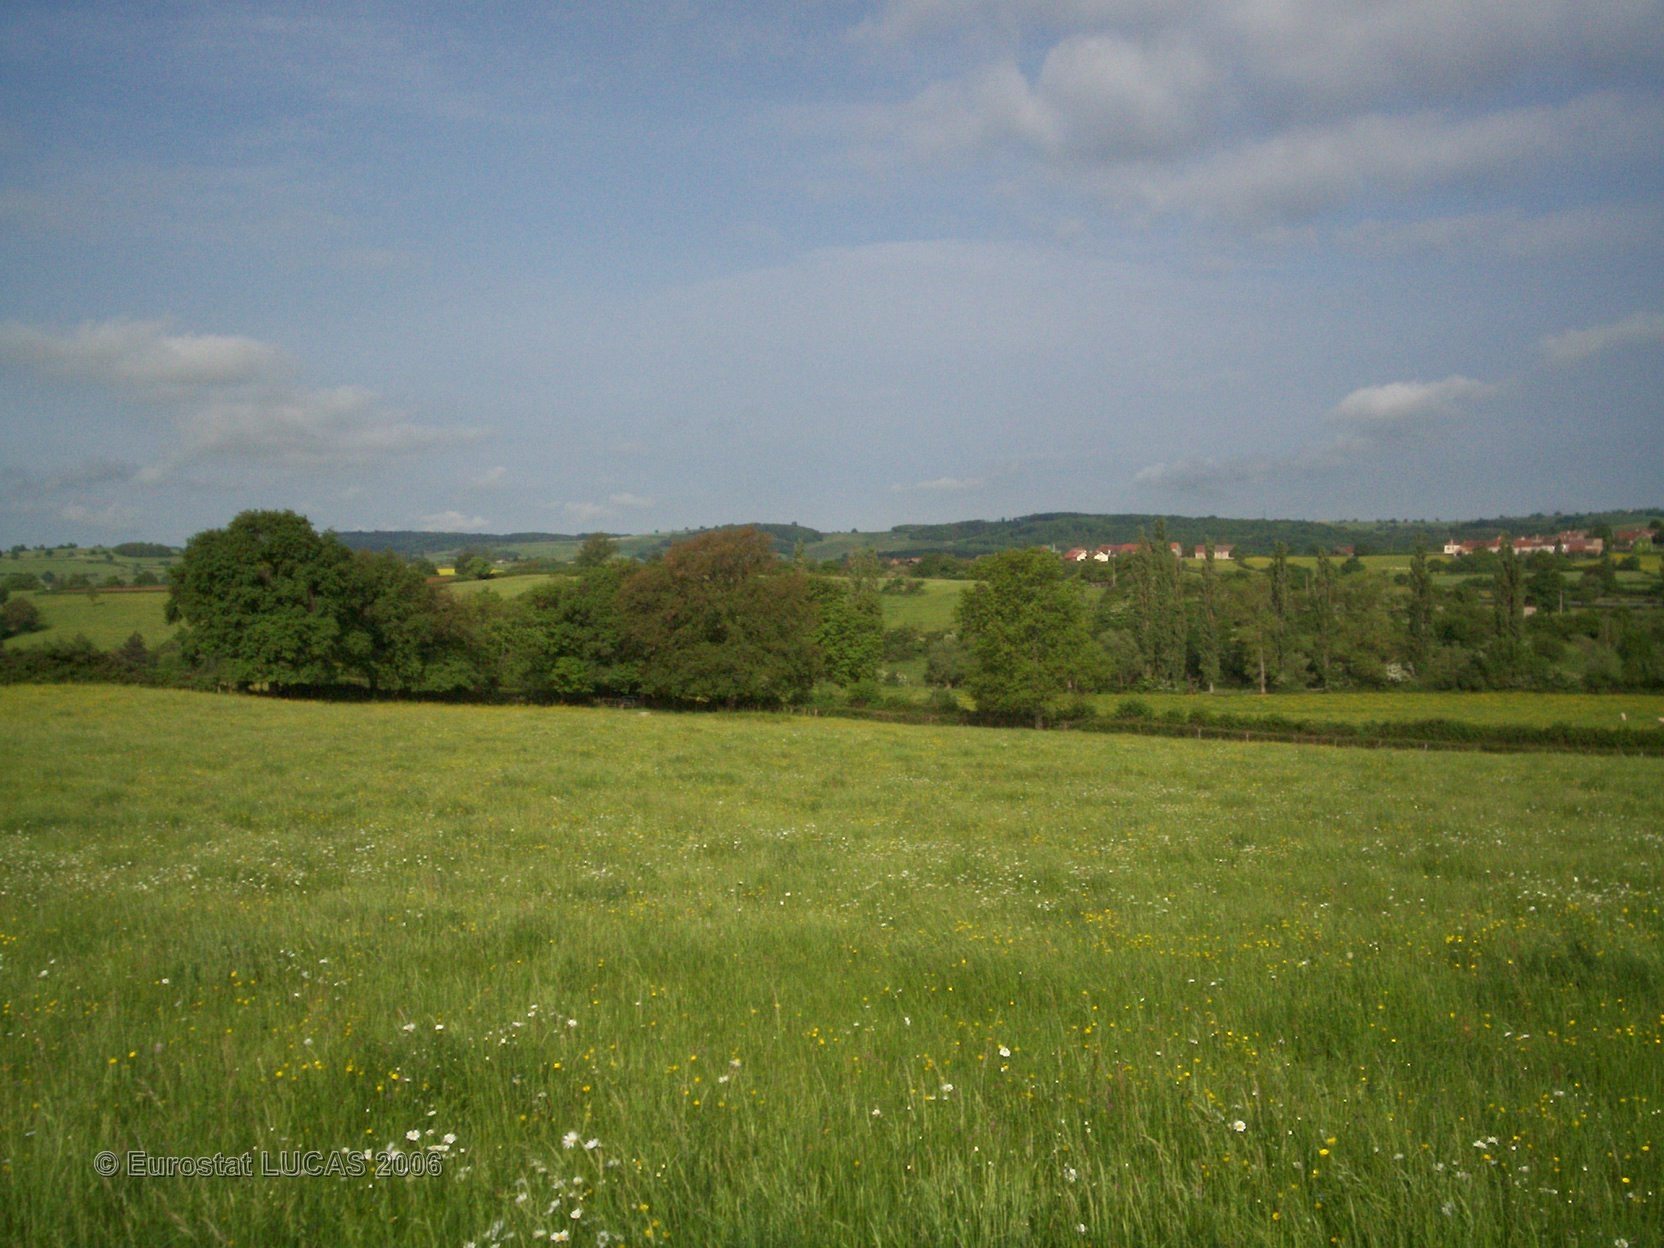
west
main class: Grassland
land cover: Grassland without tree/shrub cover
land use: Agriculture (excluding fallow land and kitchen gardens)
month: May
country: FR
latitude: 46.7406
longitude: 4.6480
